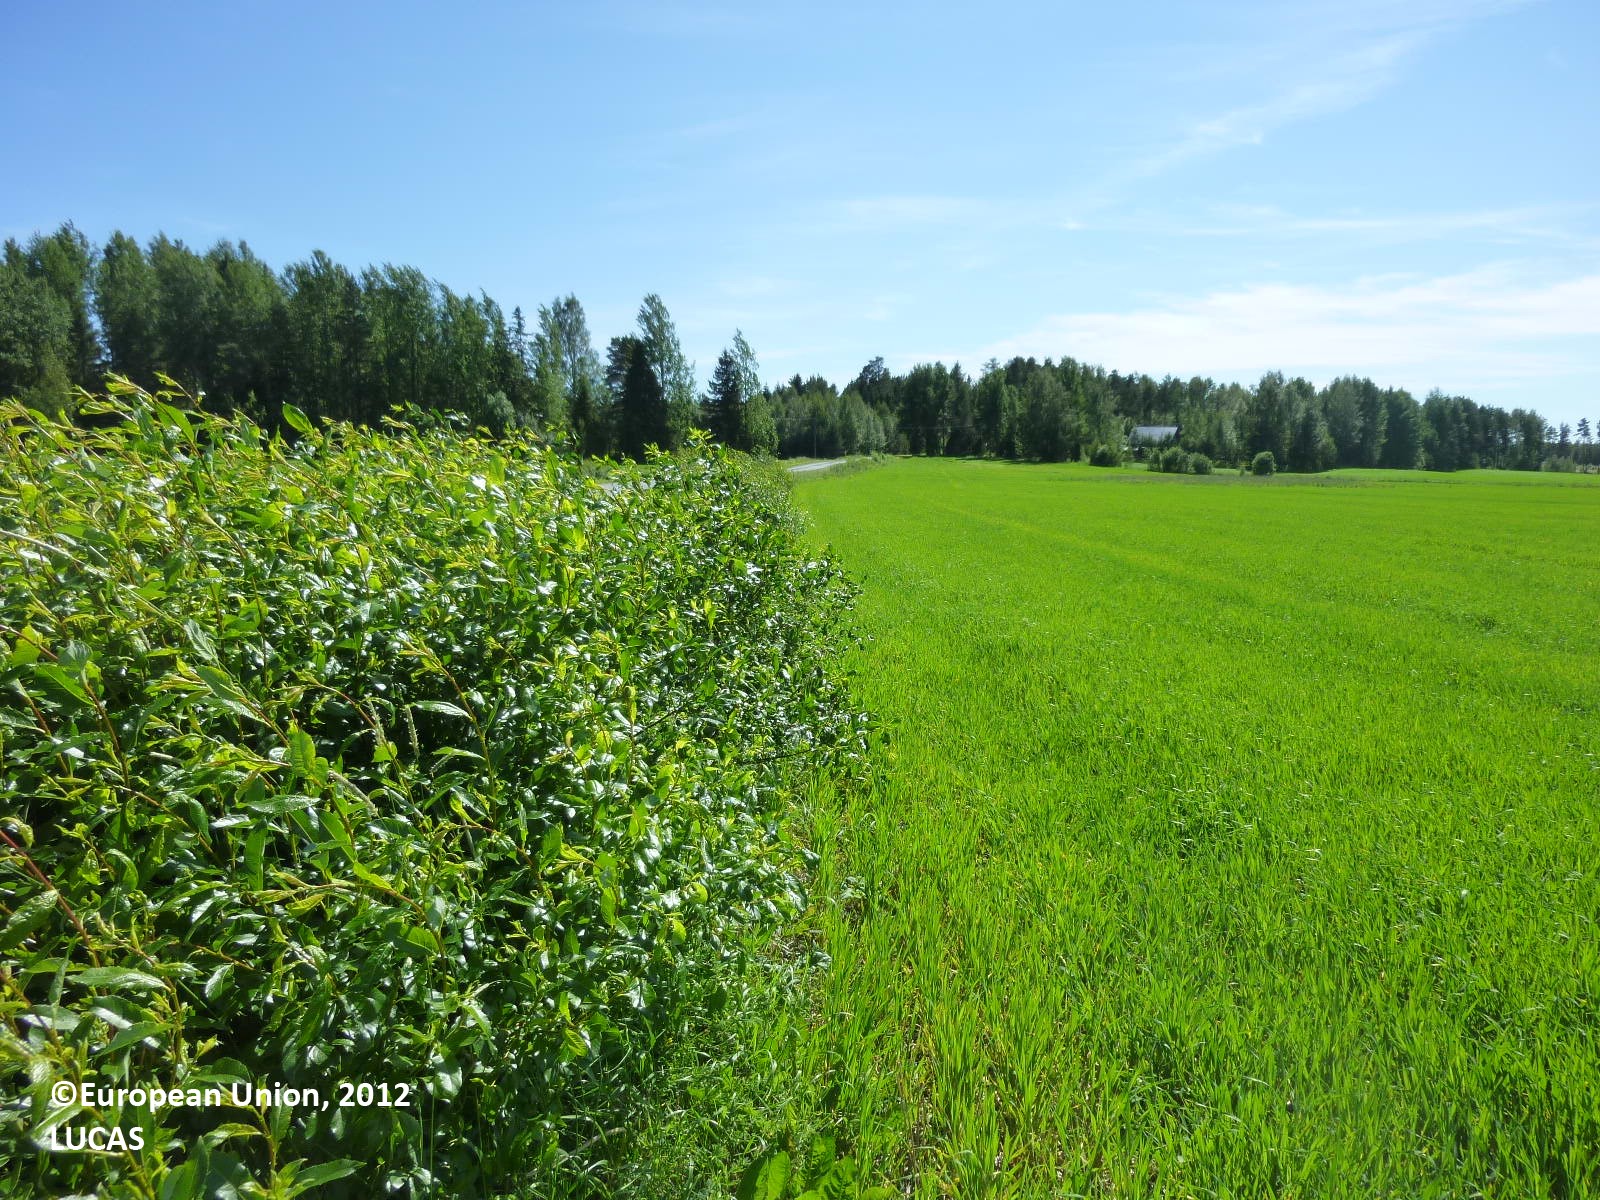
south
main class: Cropland
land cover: Barley
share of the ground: > 75 %
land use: Agriculture (excluding fallow land and kitchen gardens)
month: June
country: FI
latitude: 60.1081
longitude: 22.5761
